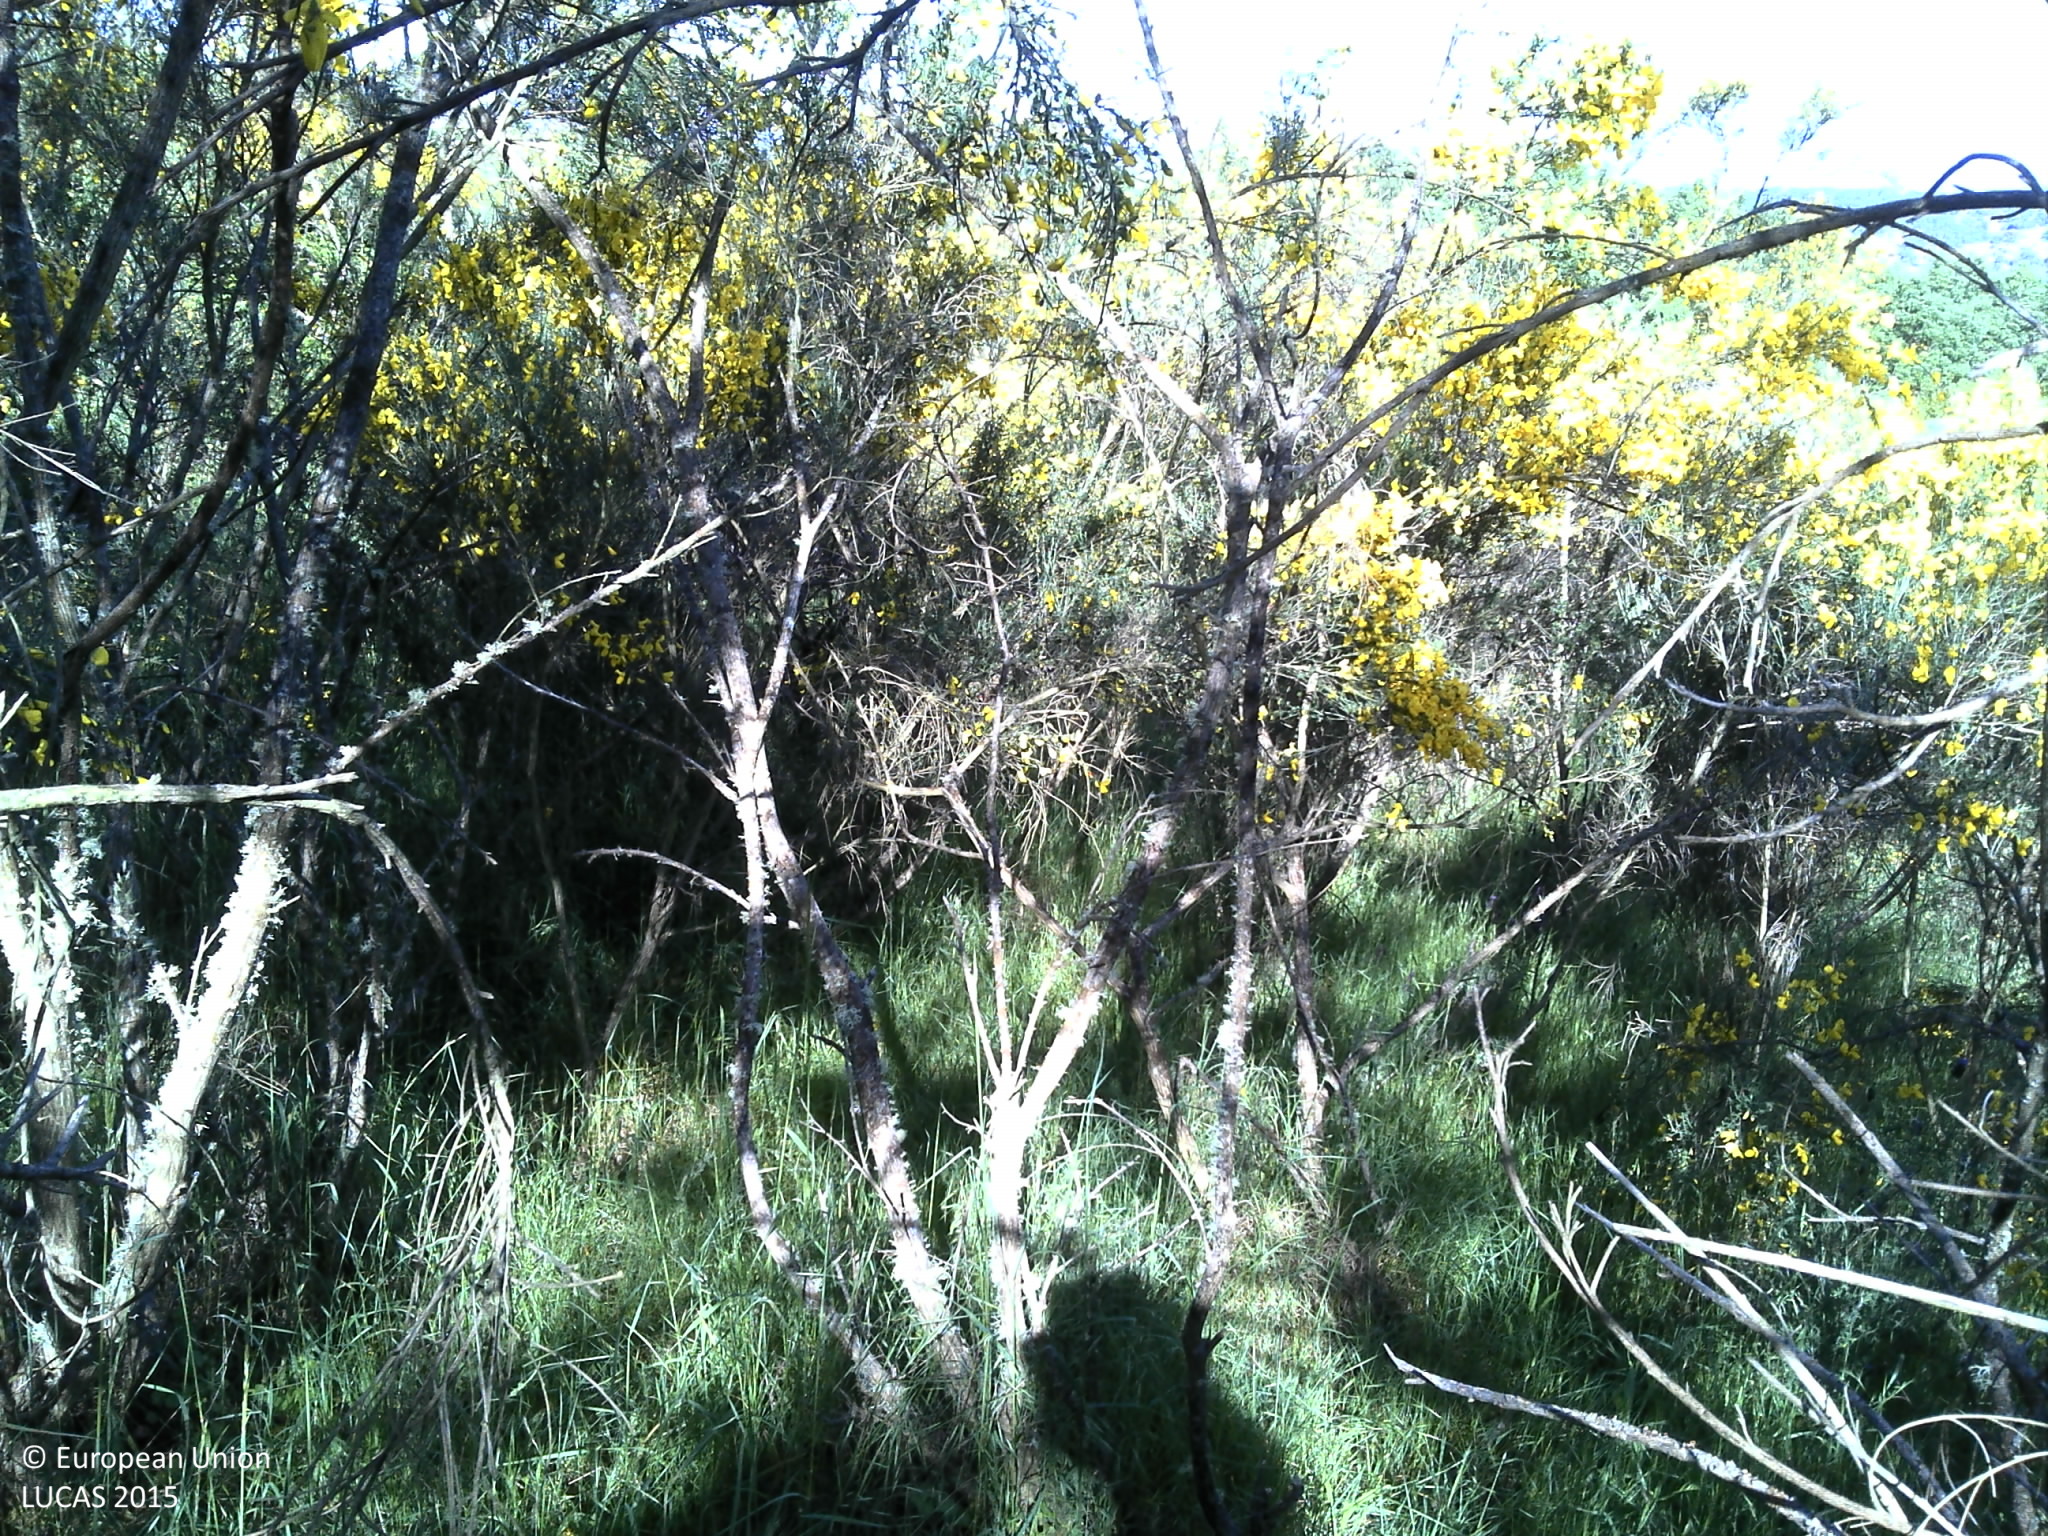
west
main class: Shrubland
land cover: Shrubland without tree cover
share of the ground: > 75 %
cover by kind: shrubs 80 %, herbaceous plants 20 %
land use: Forestry
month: May
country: PT
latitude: 41.7888
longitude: -7.3470
